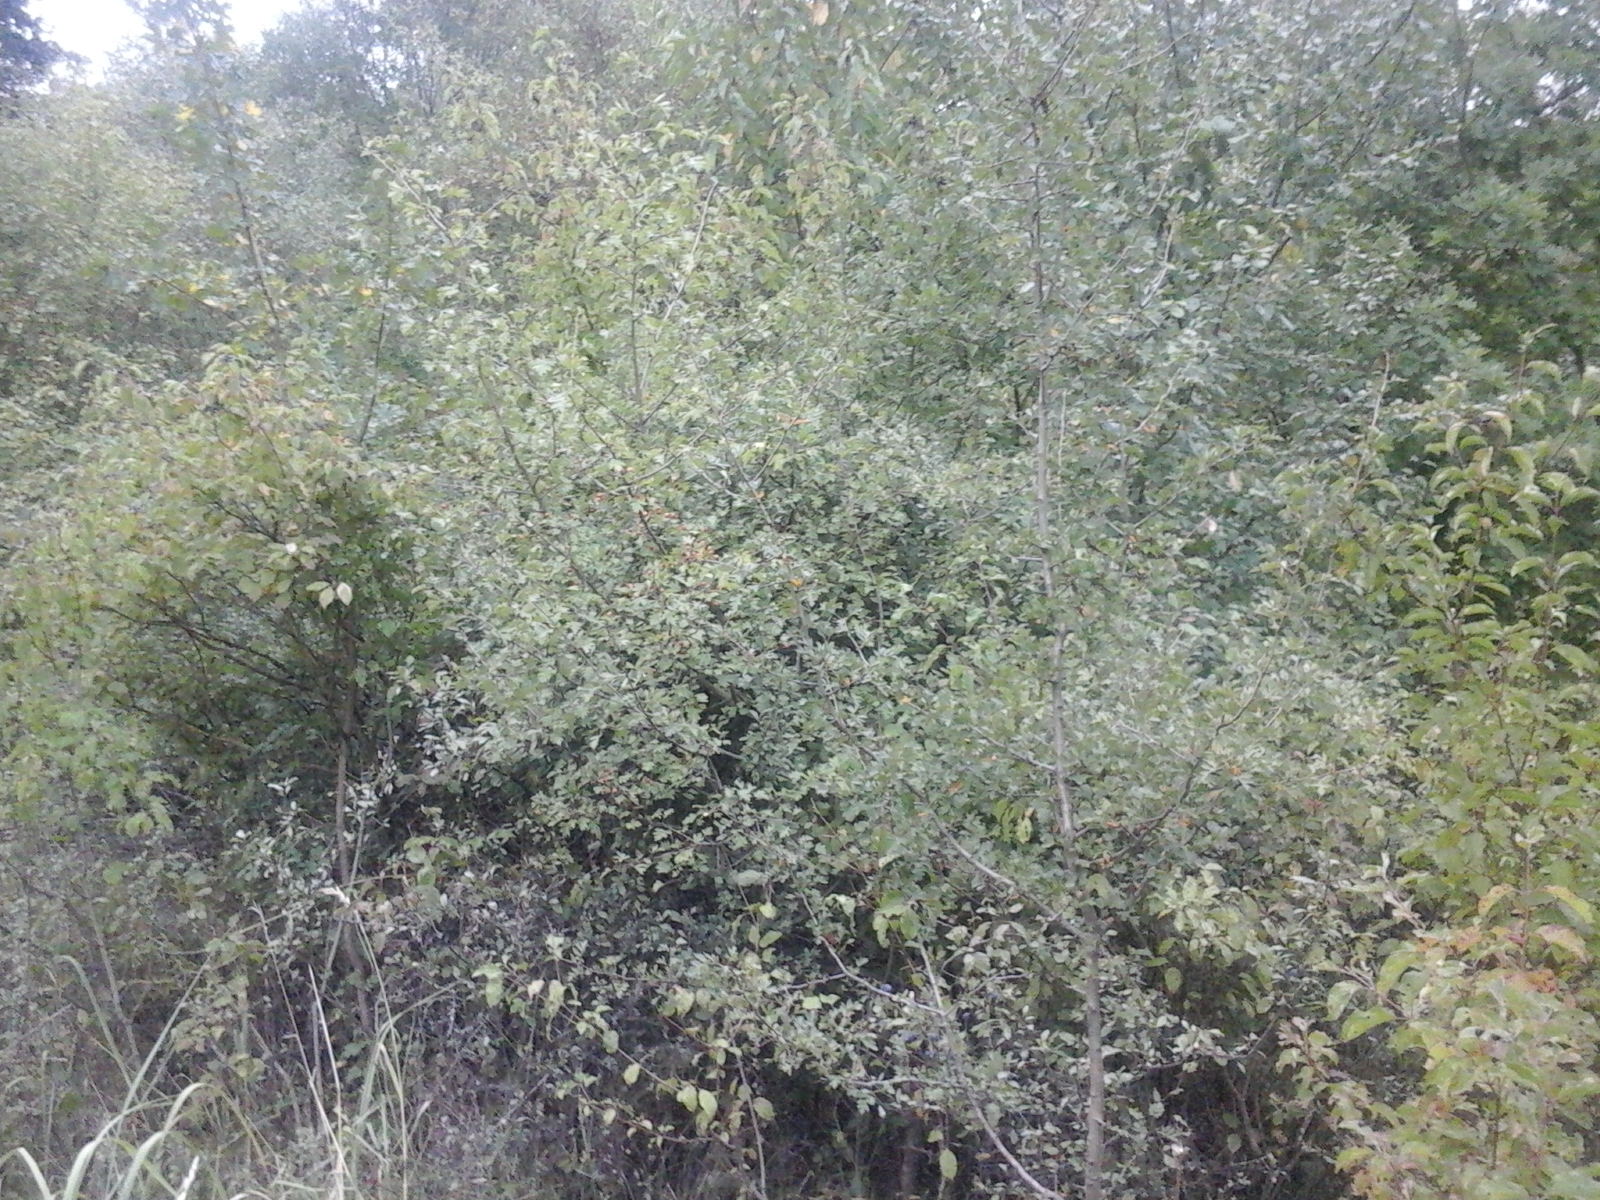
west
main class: Woodland
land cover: Broadleaved woodland
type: beech forest
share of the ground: > 75 %
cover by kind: broadleaved forest trees 100 %
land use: Forestry
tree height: > 5 m
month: August
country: RO
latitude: 45.6222
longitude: 21.6417
